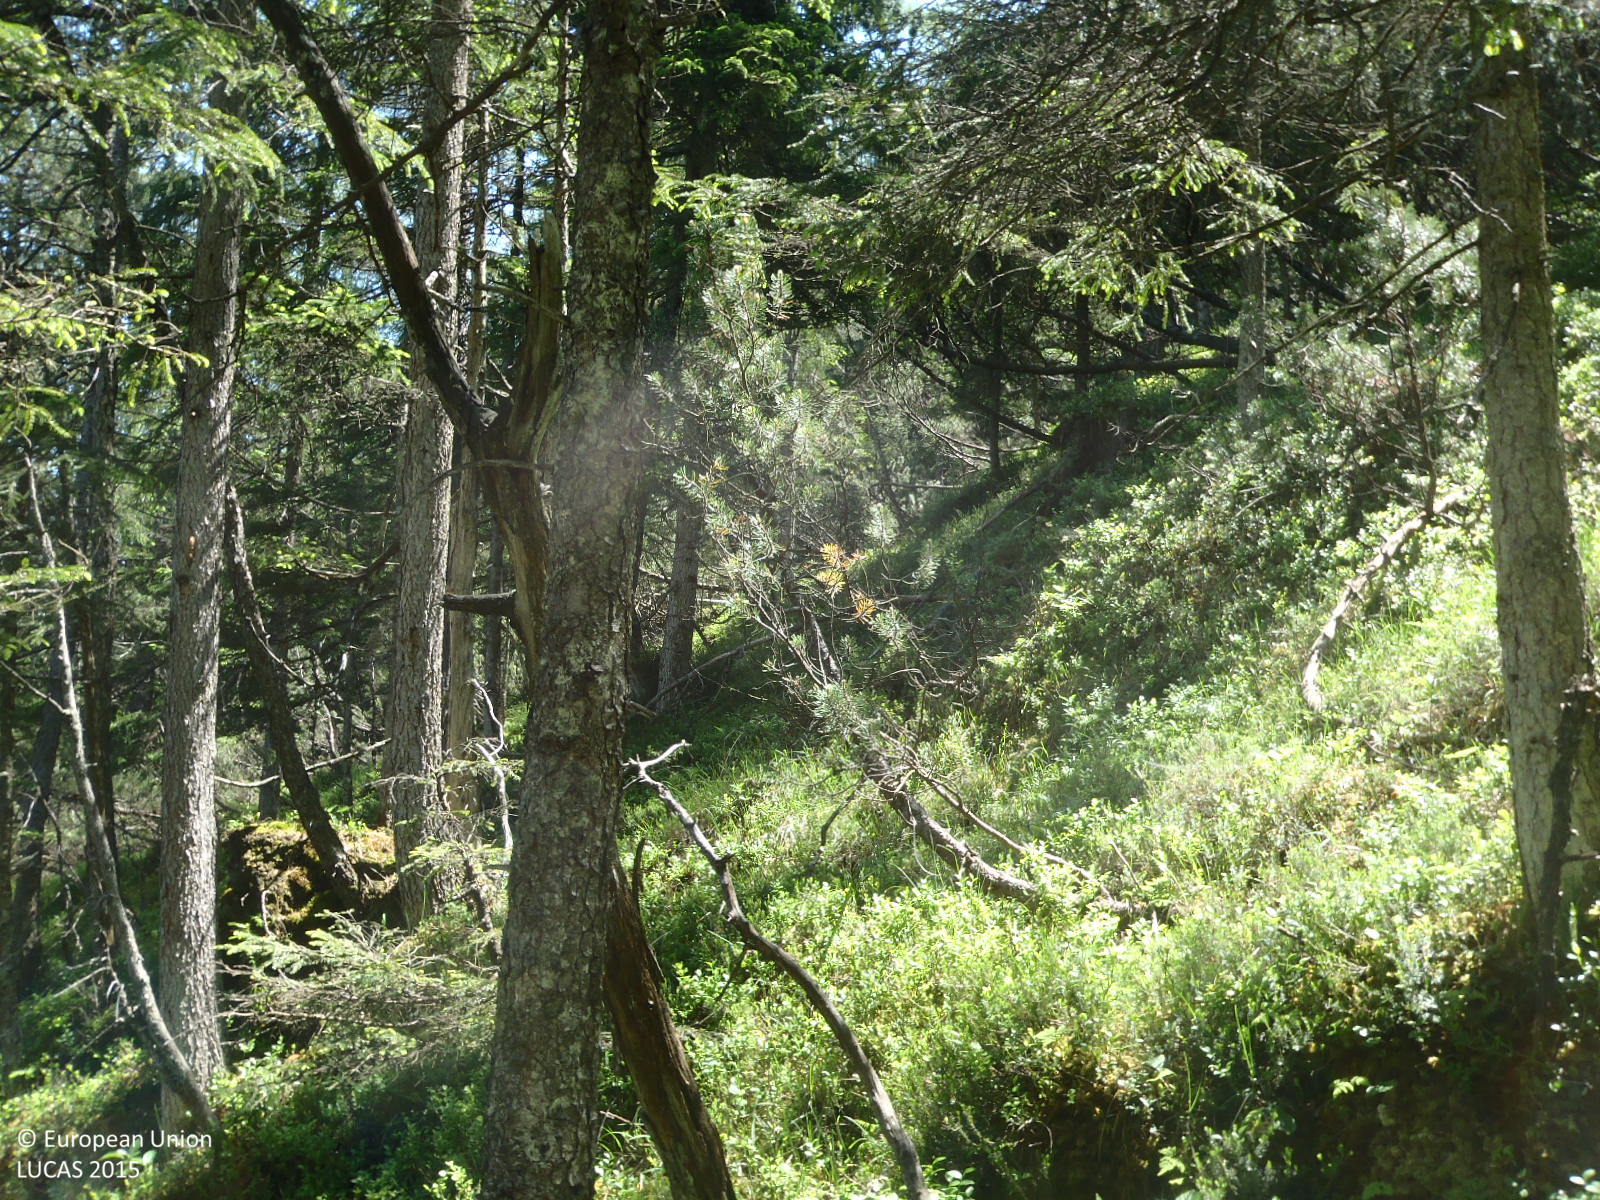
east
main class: Woodland
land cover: Spruce dominated coniferous woodland
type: alpine coniferous forest
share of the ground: > 75 %
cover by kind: coniferous forest trees 100 %
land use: Forestry
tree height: > 5 m
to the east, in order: Spruce dominated coniferous woodland; Shrubland with sparse tree cover; Other coniferous woodland; Shrubland with sparse tree cover; Rocks and stones; Other coniferous woodland; Shrubland with sparse tree cover
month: June
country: AT
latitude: 47.3562
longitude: 10.8598
